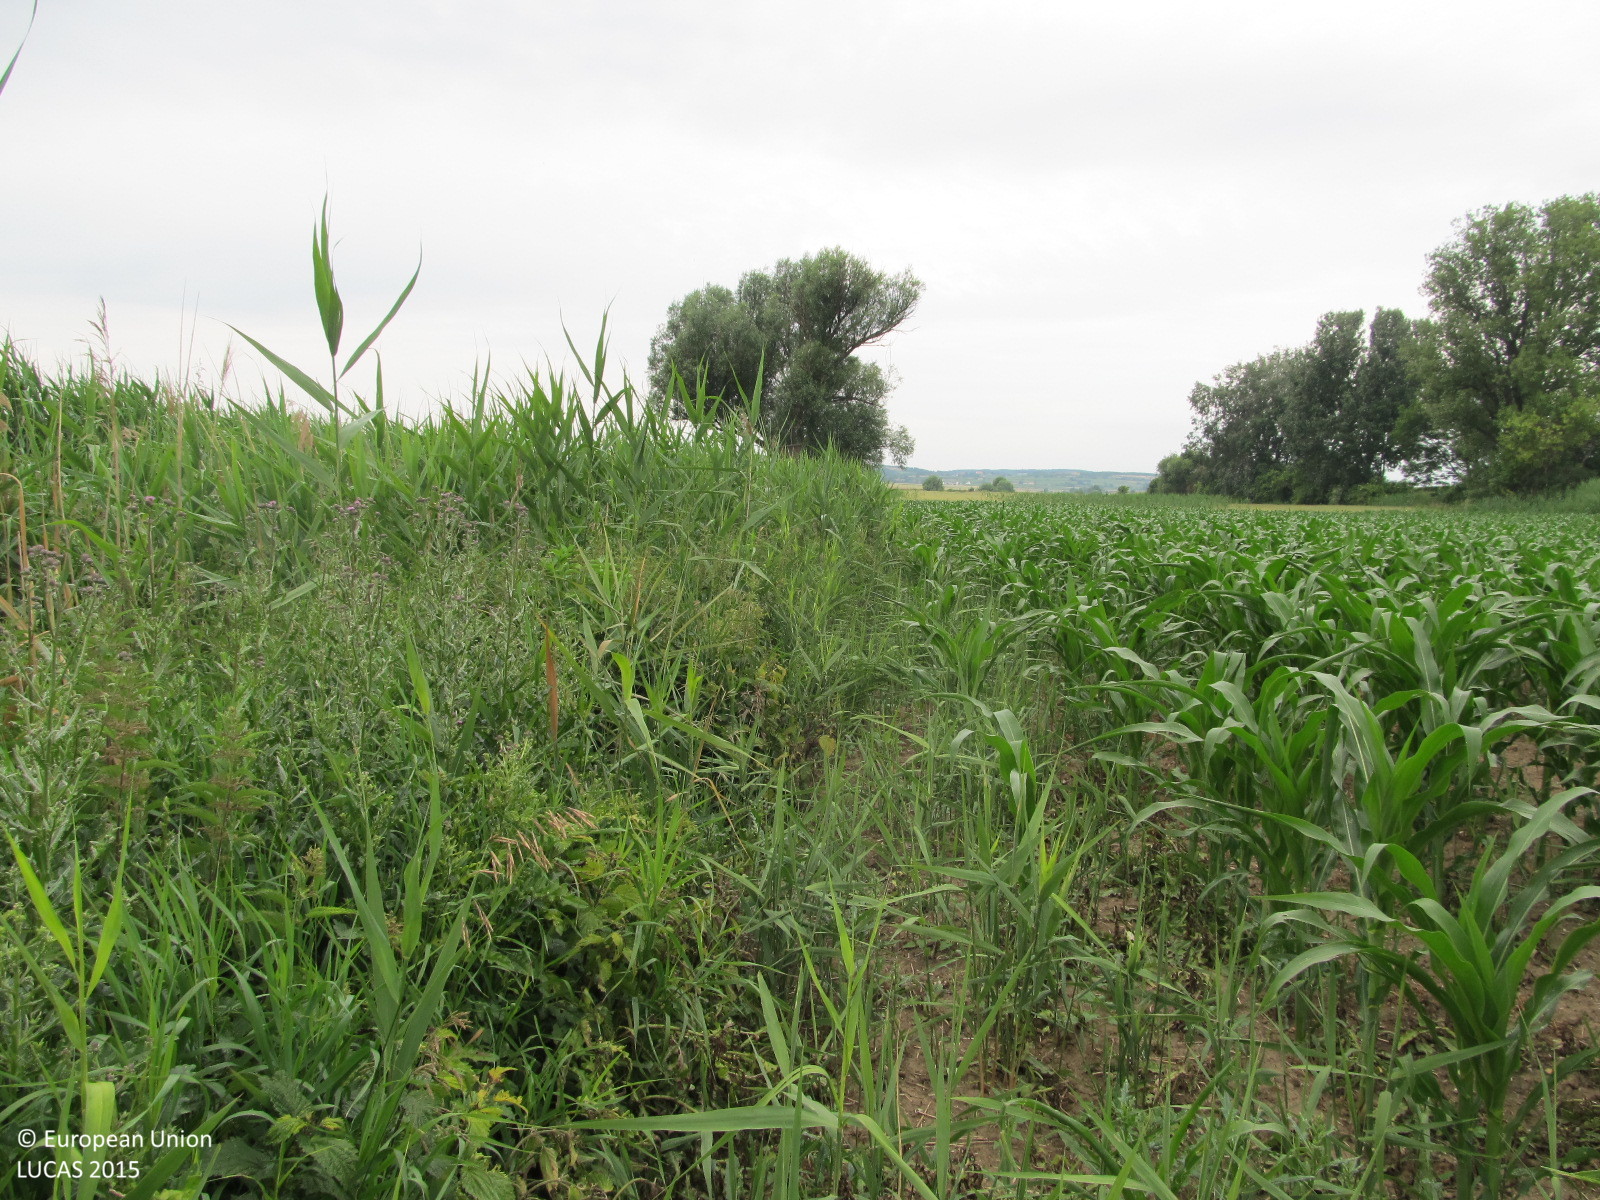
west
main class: Cropland
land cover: Barley
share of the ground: > 75 %
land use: Agriculture (excluding fallow land and kitchen gardens)
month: June
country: AT
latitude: 48.6066
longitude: 15.9036
